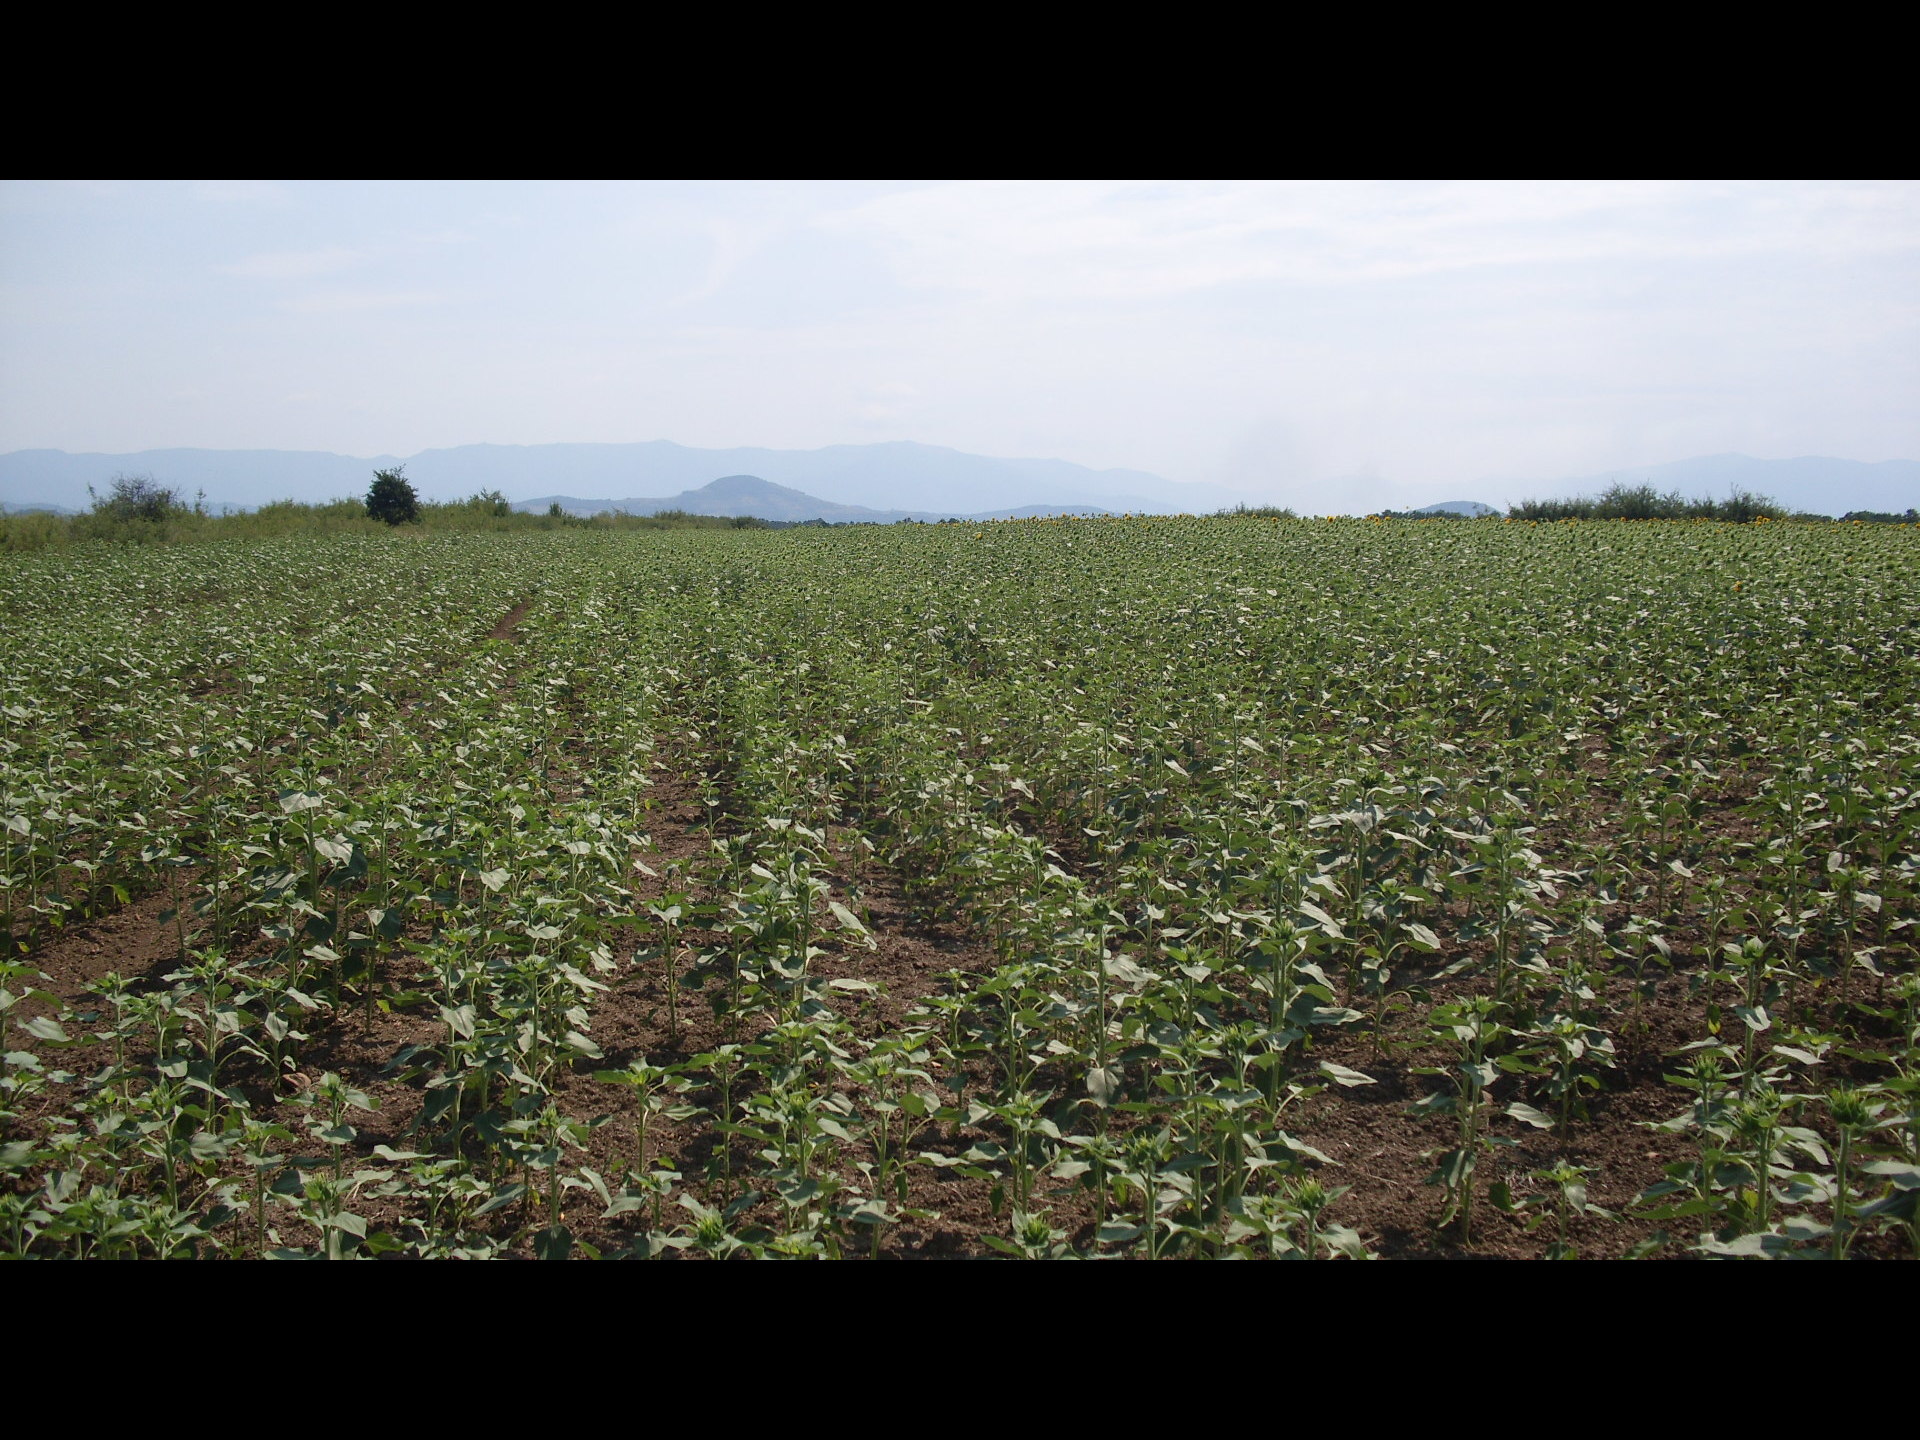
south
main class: Cropland
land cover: Sunflower
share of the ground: 25 - 50 %
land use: Agriculture (excluding fallow land and kitchen gardens)
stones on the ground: < 10 %
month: August
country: BG
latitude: 43.3470
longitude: 23.2767
